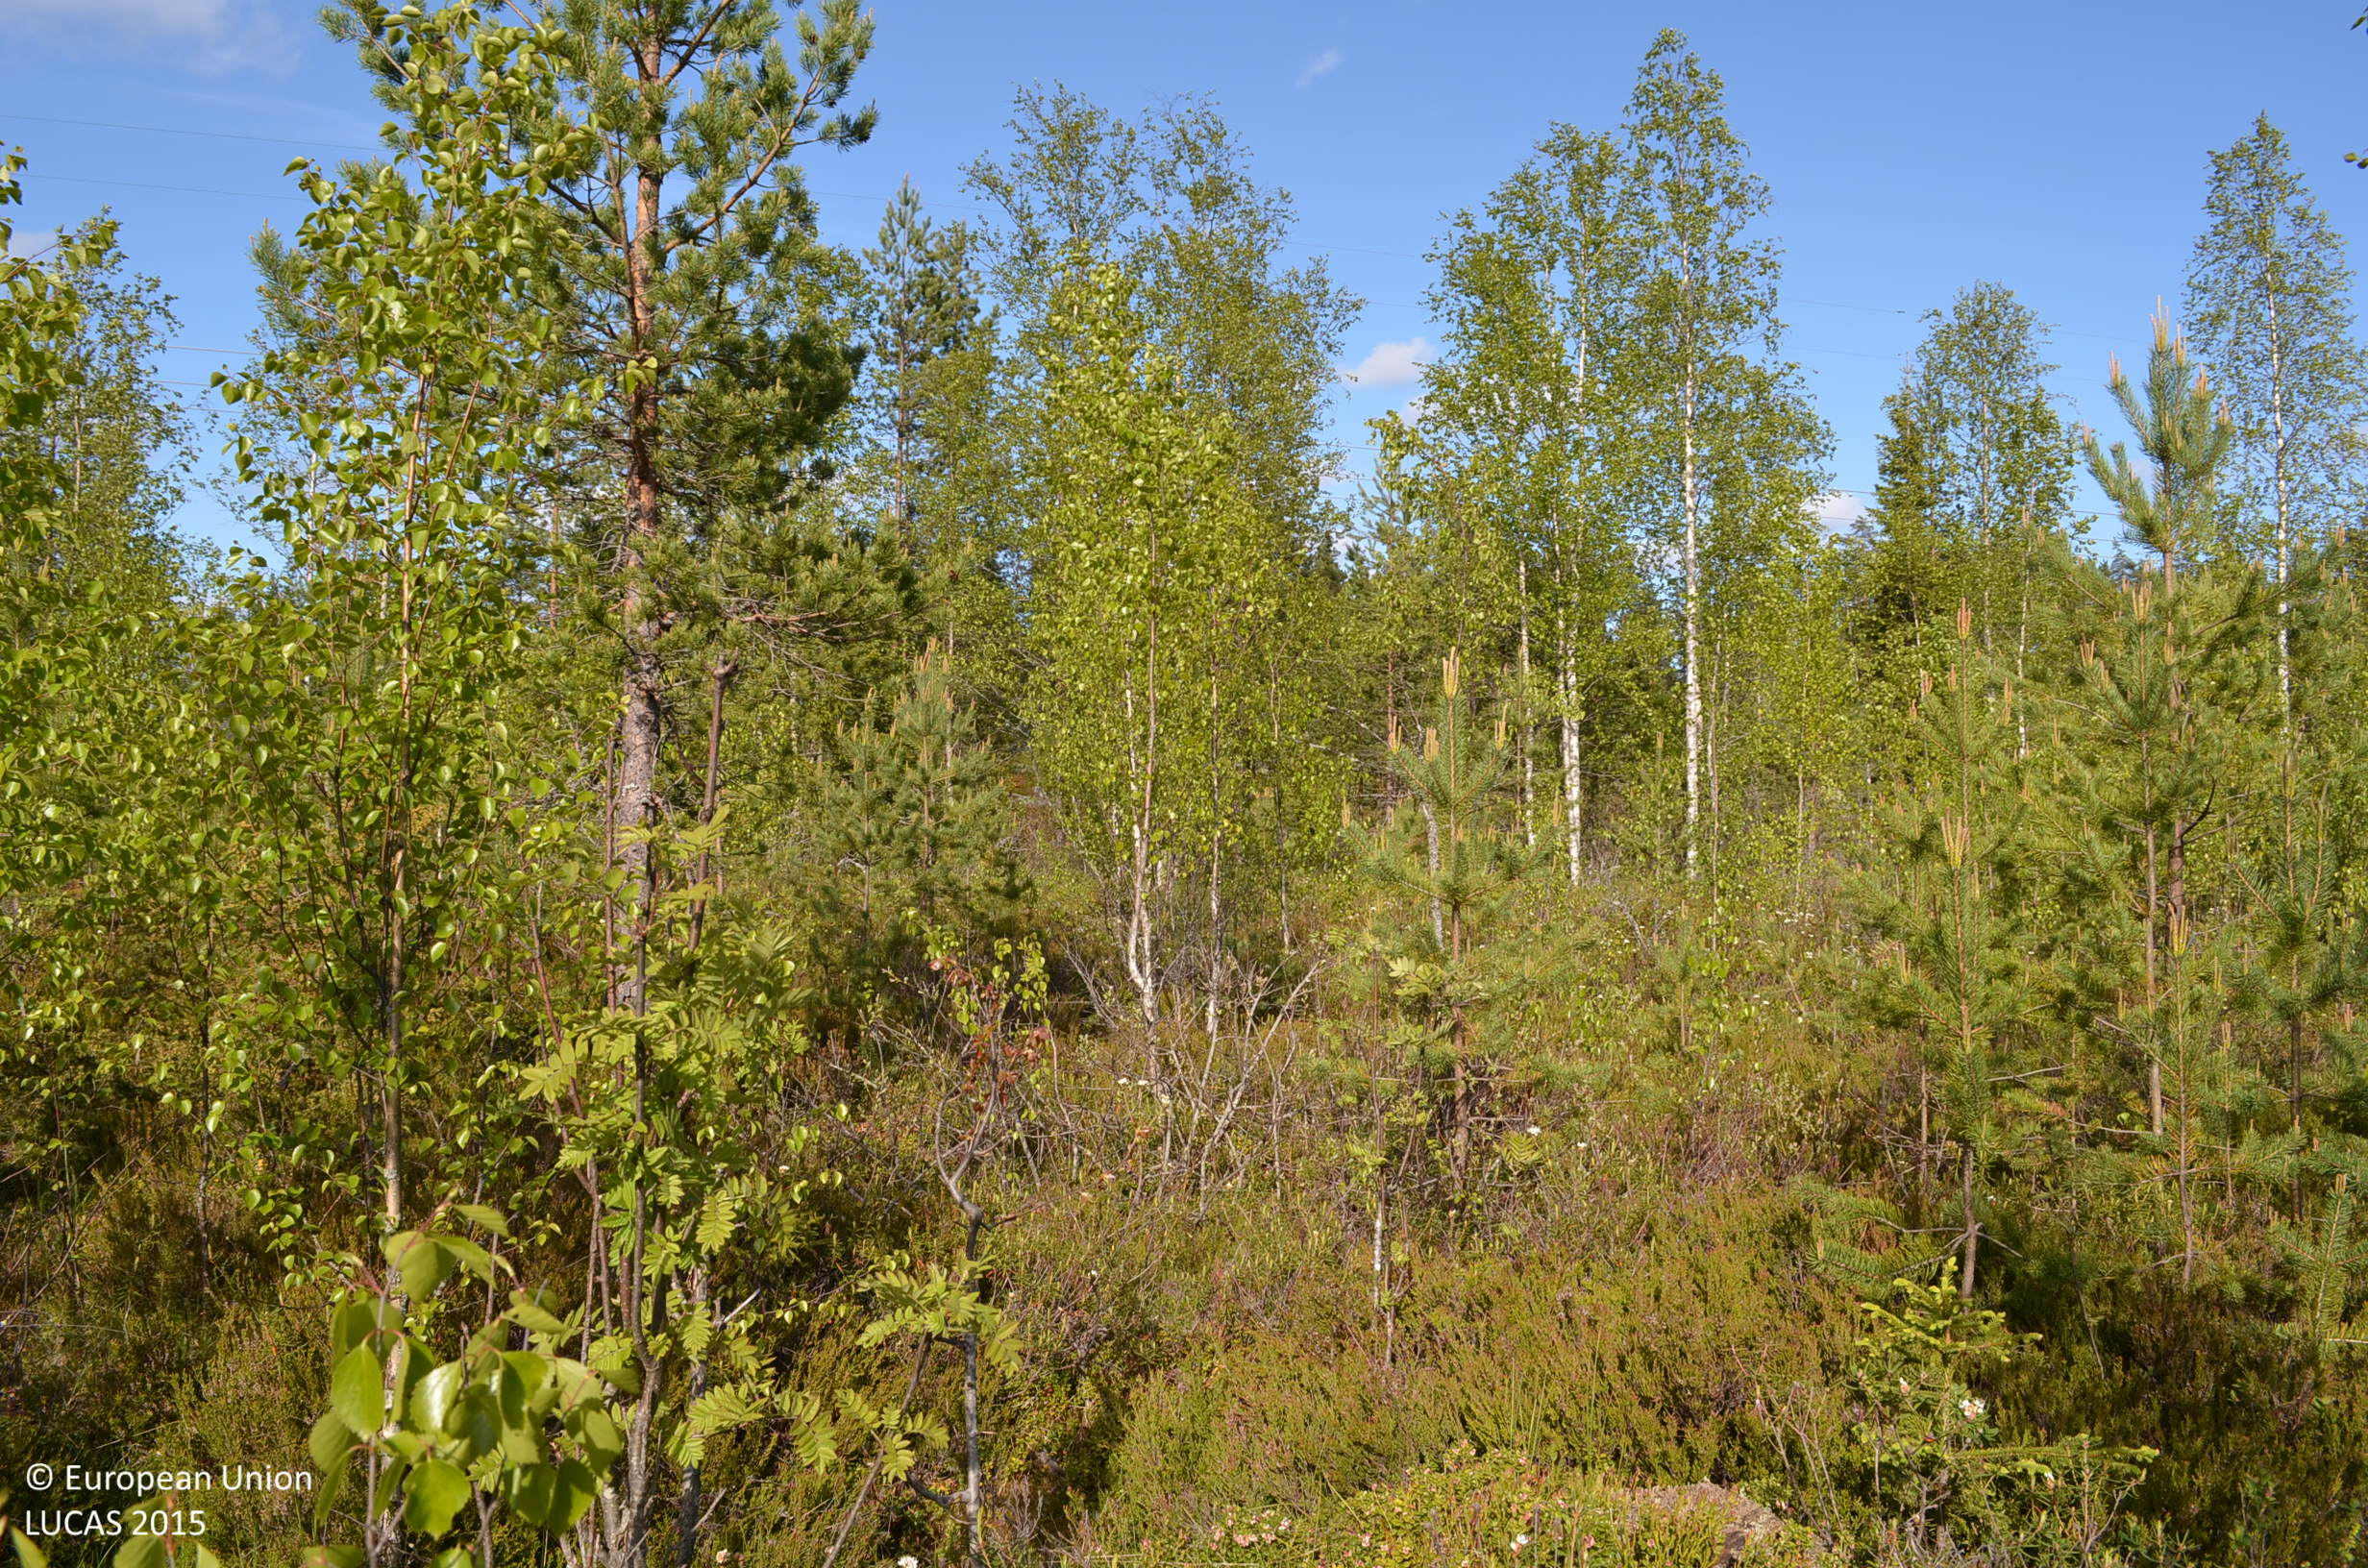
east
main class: Woodland
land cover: Pine dominated mixed woodland
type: boreal forest
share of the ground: 50 - 75 %
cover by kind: shrubs 50 %, coniferous forest trees 25 %, broadleaved forest trees 25 %
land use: Forestry
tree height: < 5 m
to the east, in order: Pine dominated mixed woodland; Shrubland without tree cover; Electric lines; Pine dominated mixed woodland; Pine dominated coniferous woodland
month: June
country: FI
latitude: 61.8558
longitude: 23.2806
